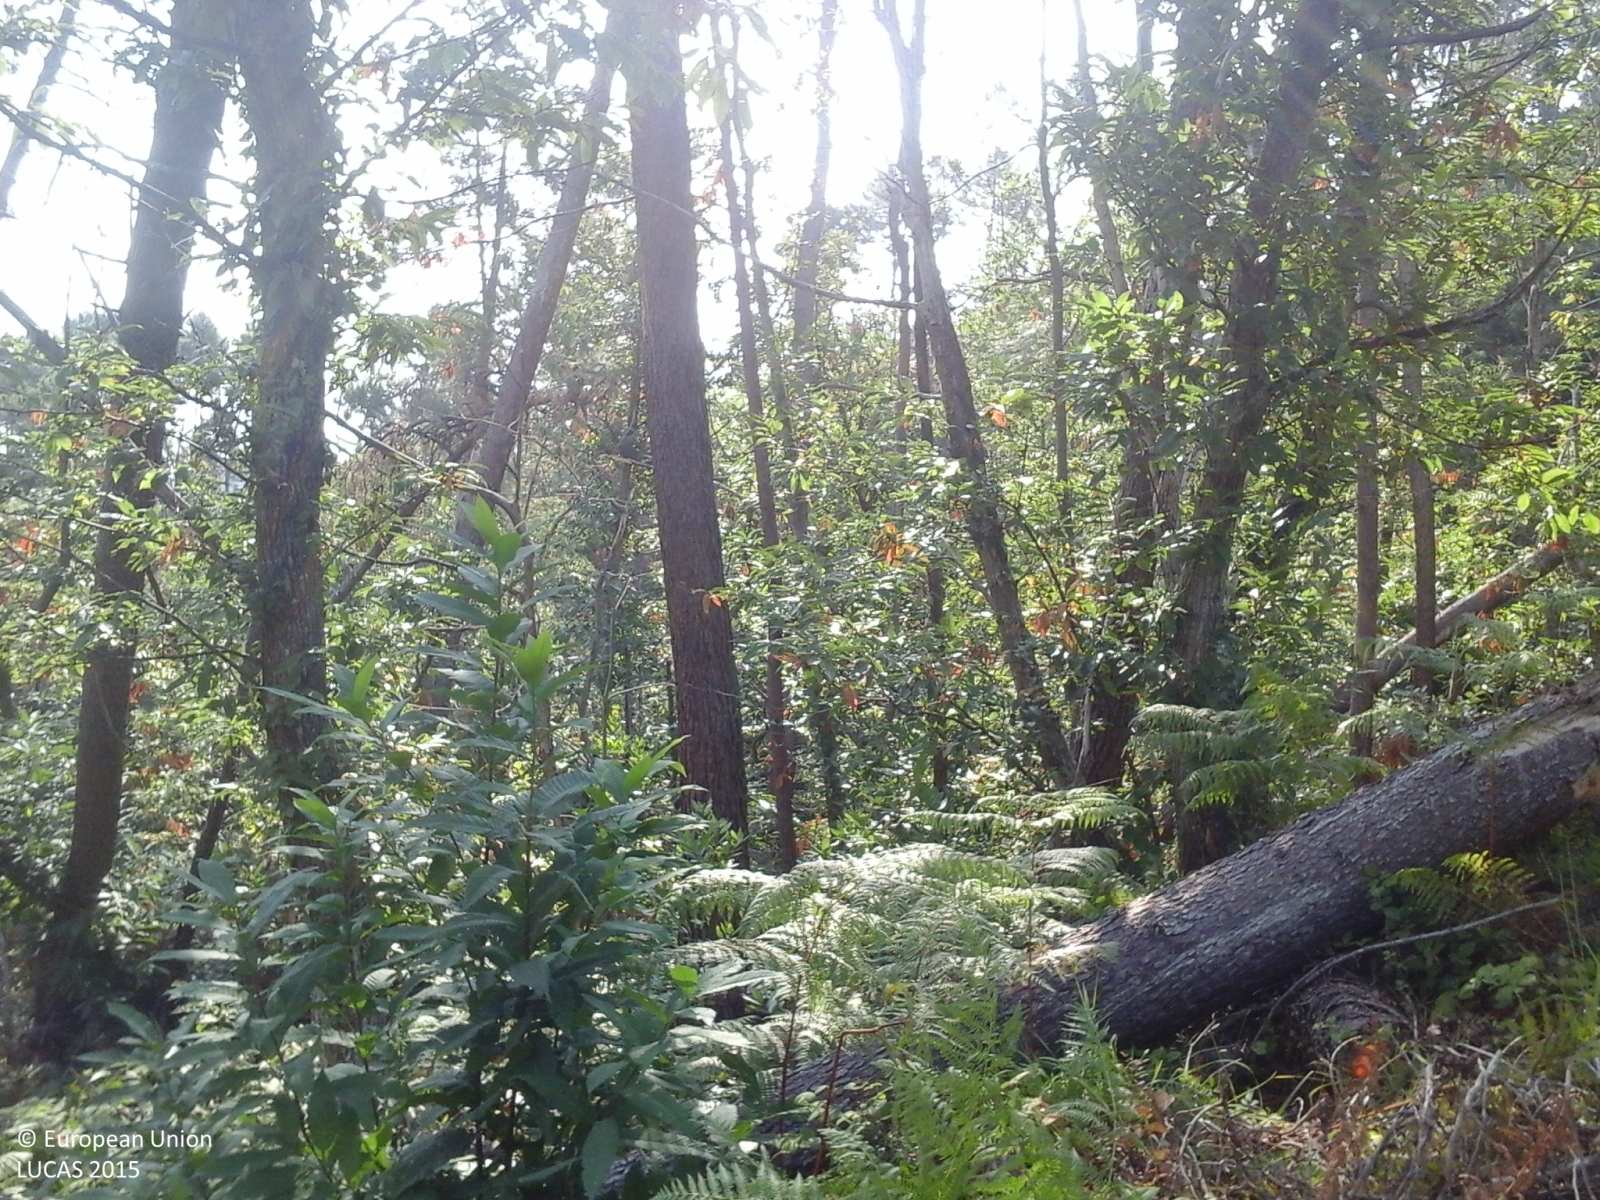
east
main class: Woodland
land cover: Other mixed woodland
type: thermophilous deciduous forest
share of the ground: > 75 %
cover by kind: broadleaved forest trees 60 %, coniferous forest trees 30 %, shrubs 10 %
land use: Forestry
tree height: > 5 m
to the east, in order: Other mixed woodland; Tracks; Other mixed woodland
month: August
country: IT
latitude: 43.8990
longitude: 10.3353
